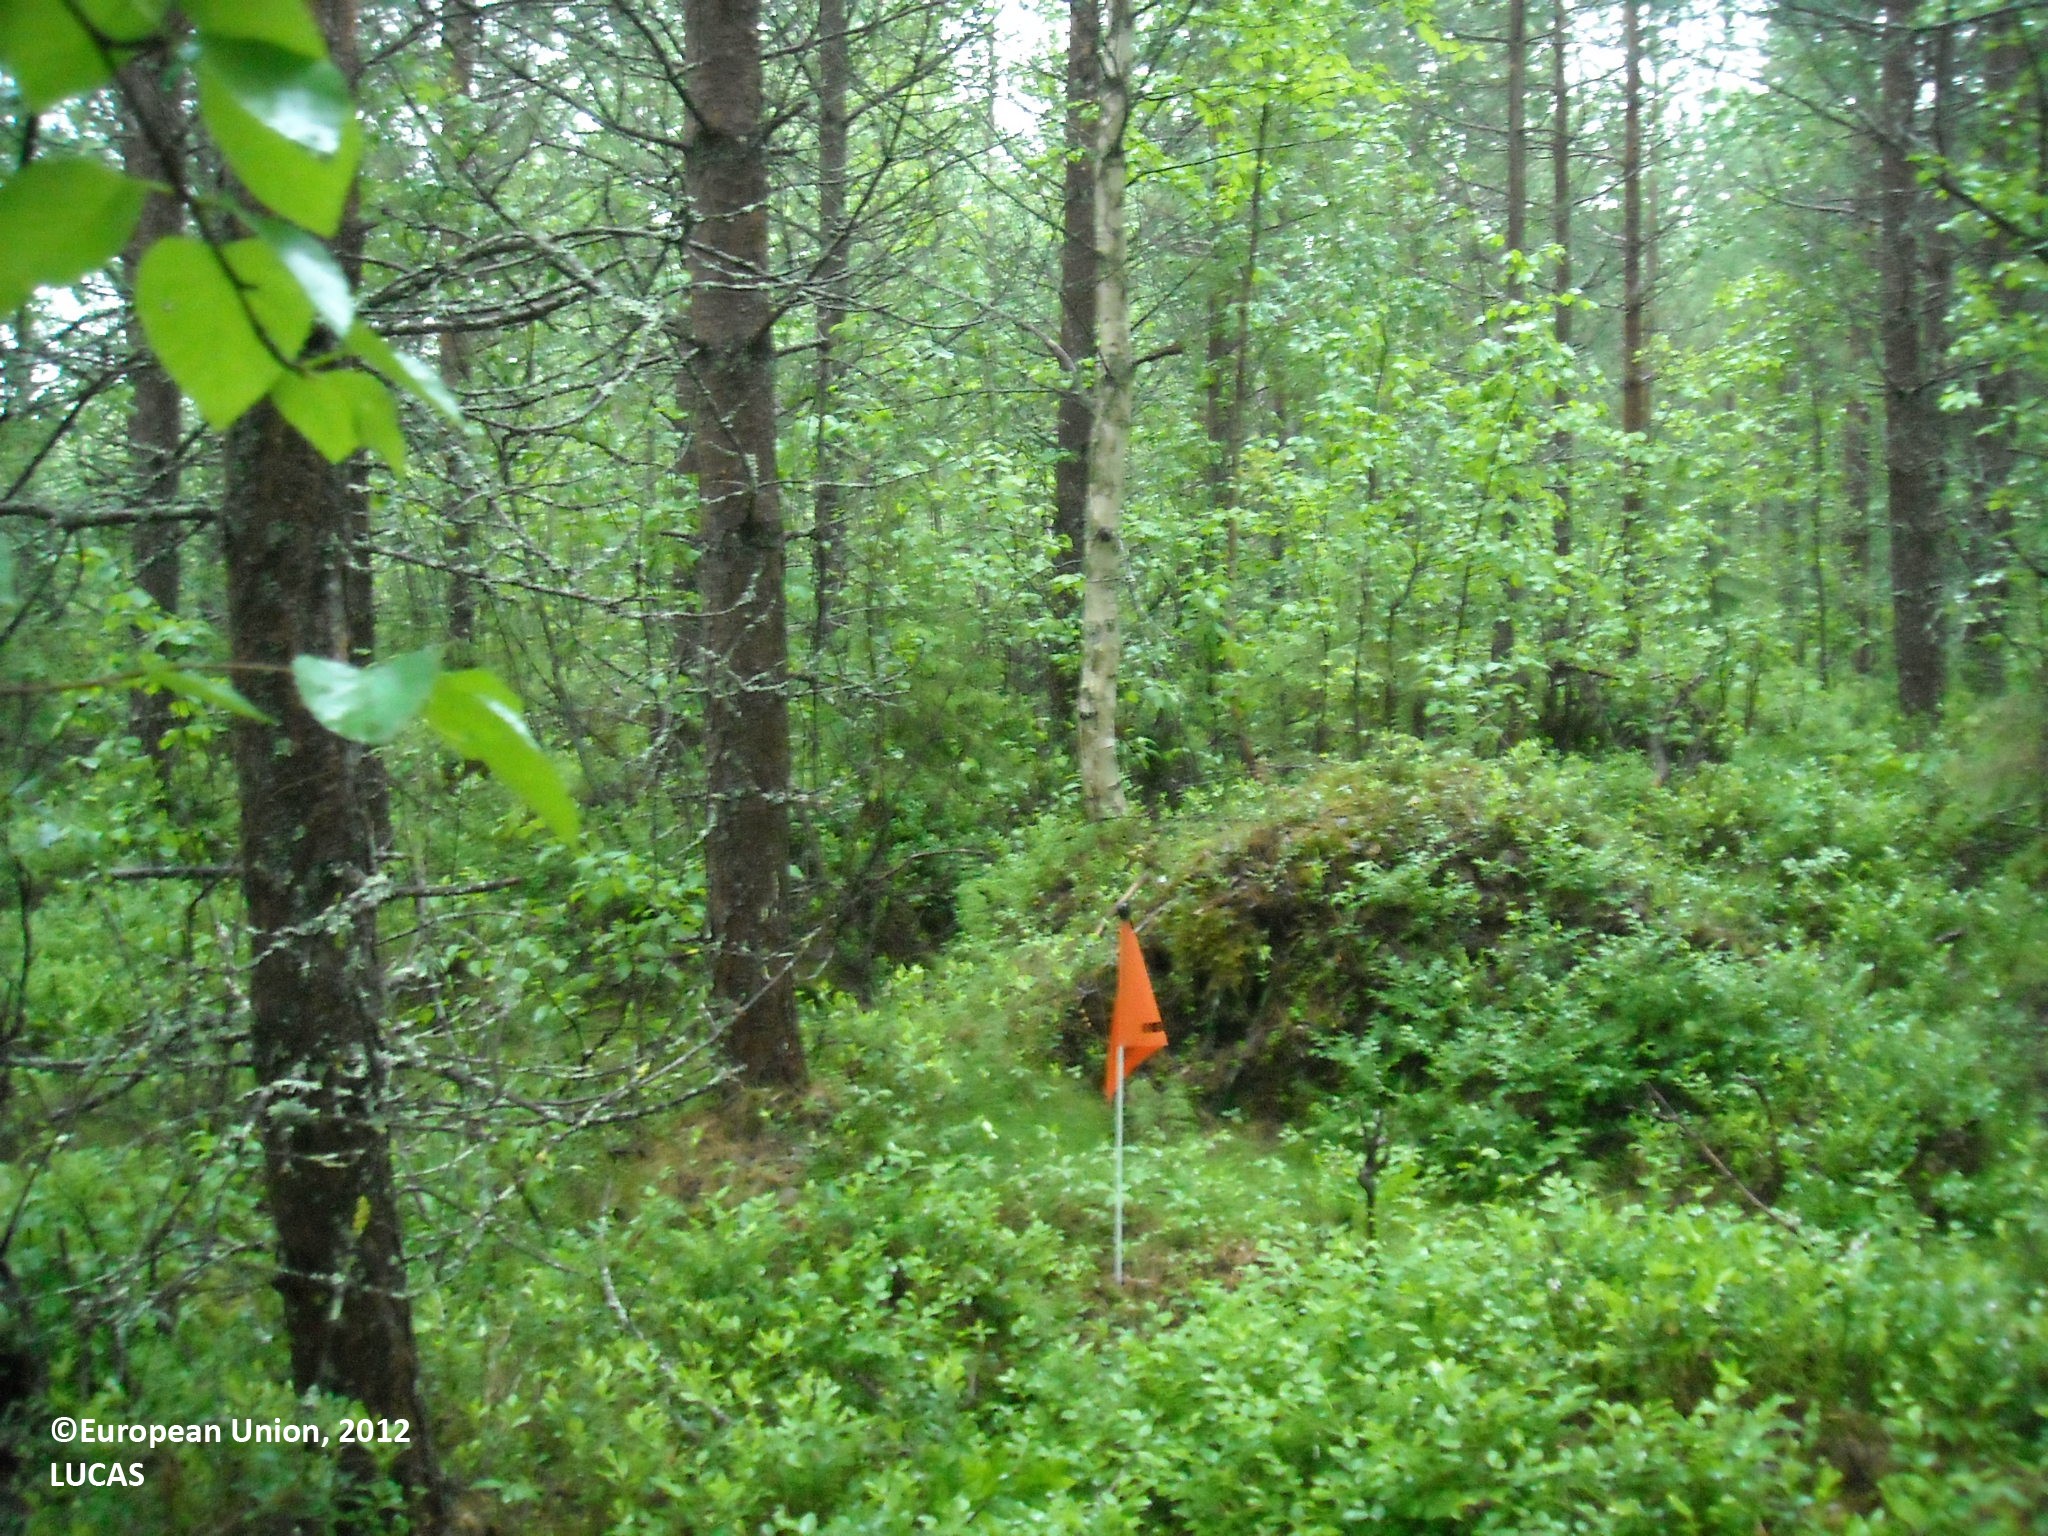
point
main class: Woodland
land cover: Pine dominated mixed woodland
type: boreal forest
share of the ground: > 75 %
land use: Forestry
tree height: > 5 m
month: July
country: FI
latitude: 65.0403
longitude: 28.1015
